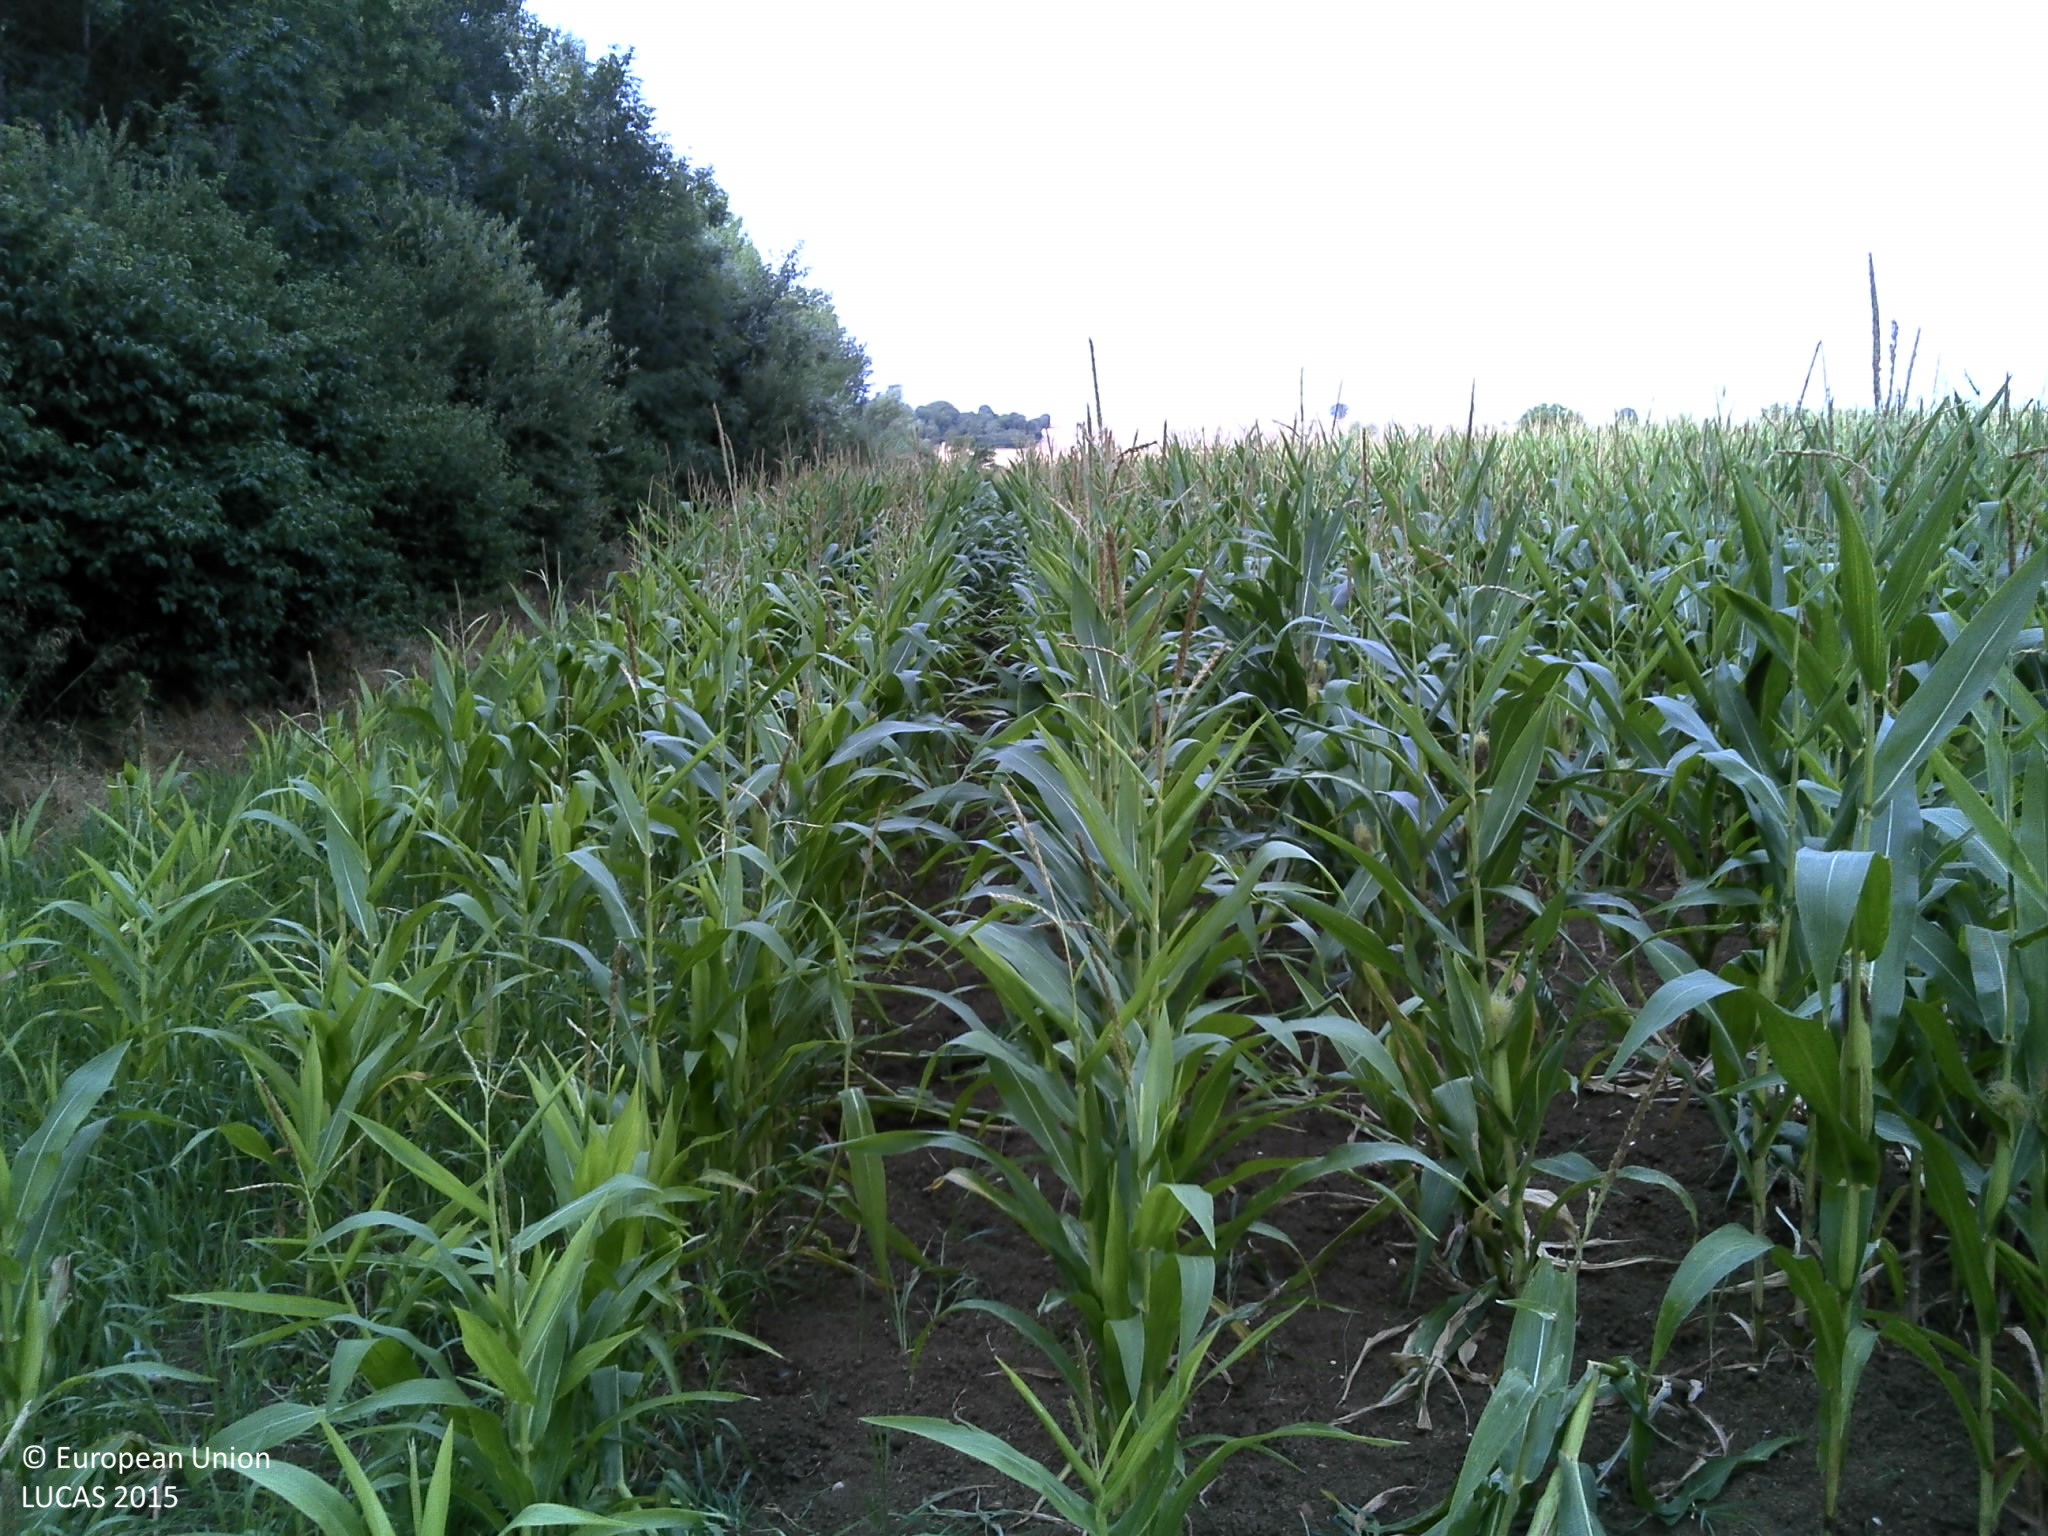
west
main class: Cropland
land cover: Maize
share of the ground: 50 - 75 %
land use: Agriculture (excluding fallow land and kitchen gardens)
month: July
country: FR
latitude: 48.6852
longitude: 4.5775
